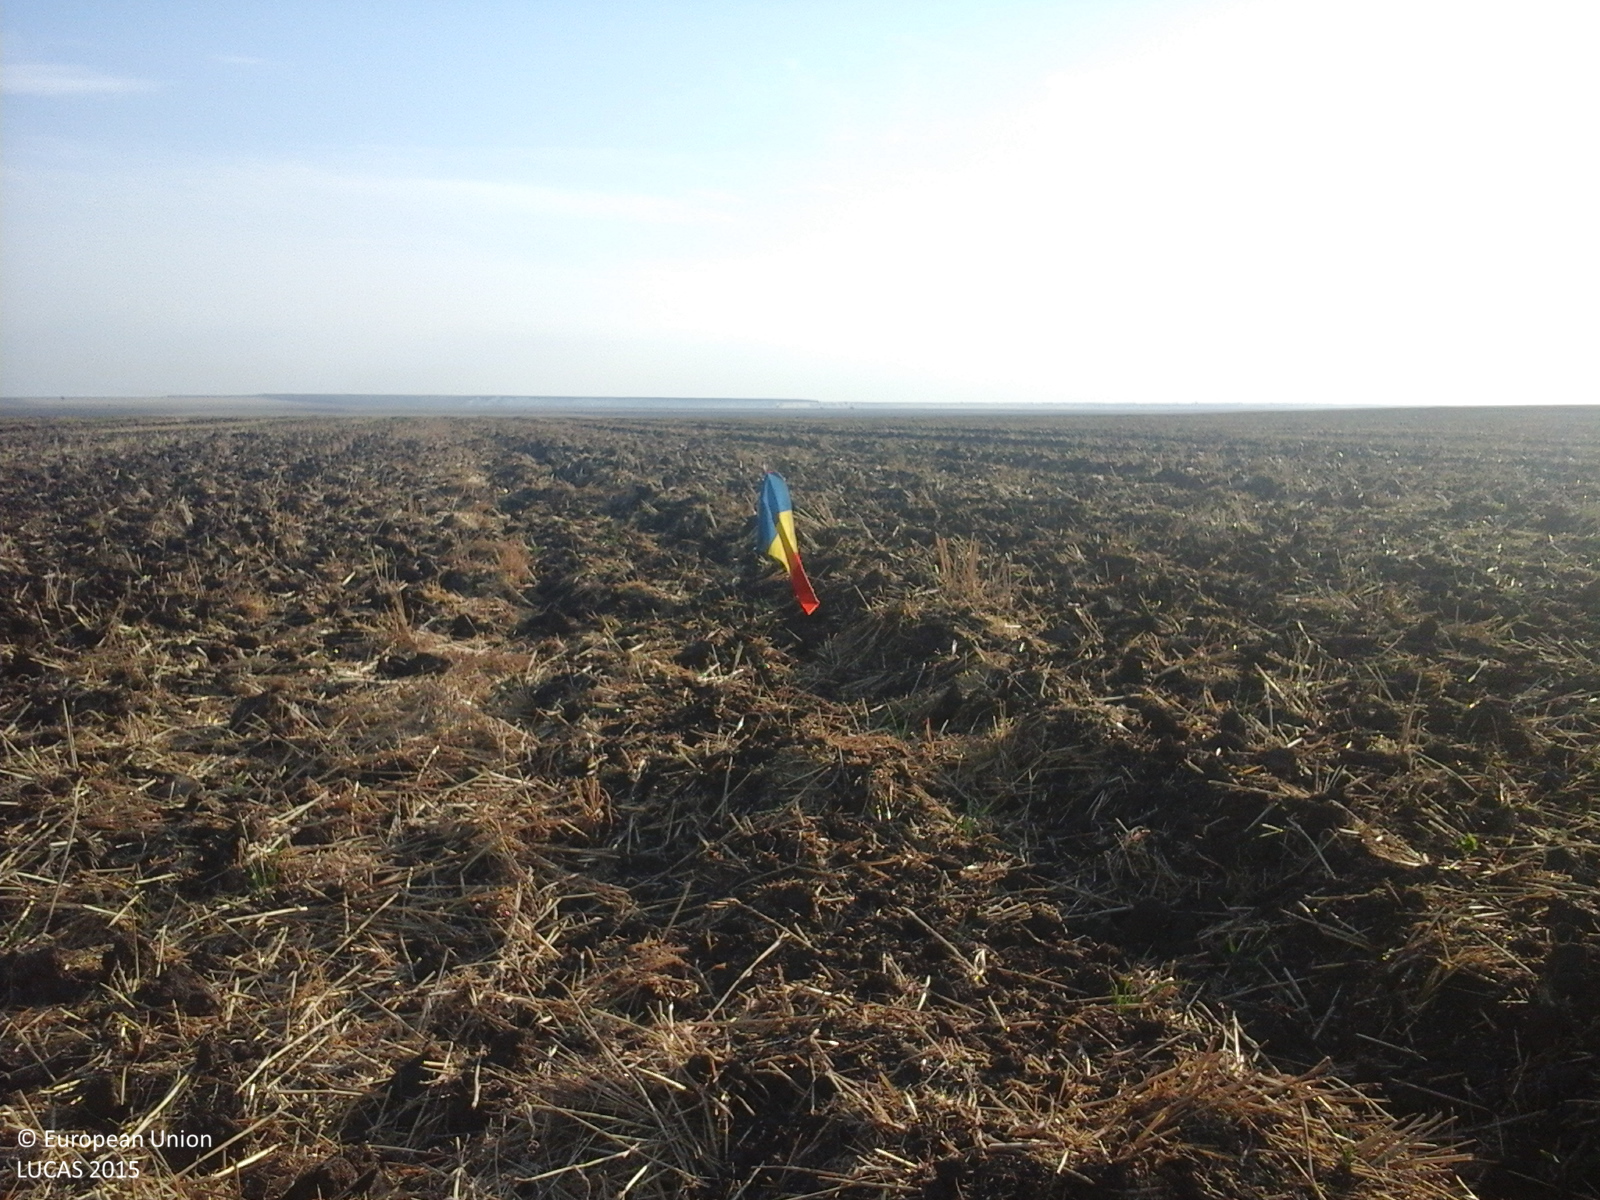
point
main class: Cropland
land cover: Common wheat
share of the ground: < 10 %
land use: Agriculture (excluding fallow land and kitchen gardens)
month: August
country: RO
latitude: 44.1922
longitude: 23.0937
